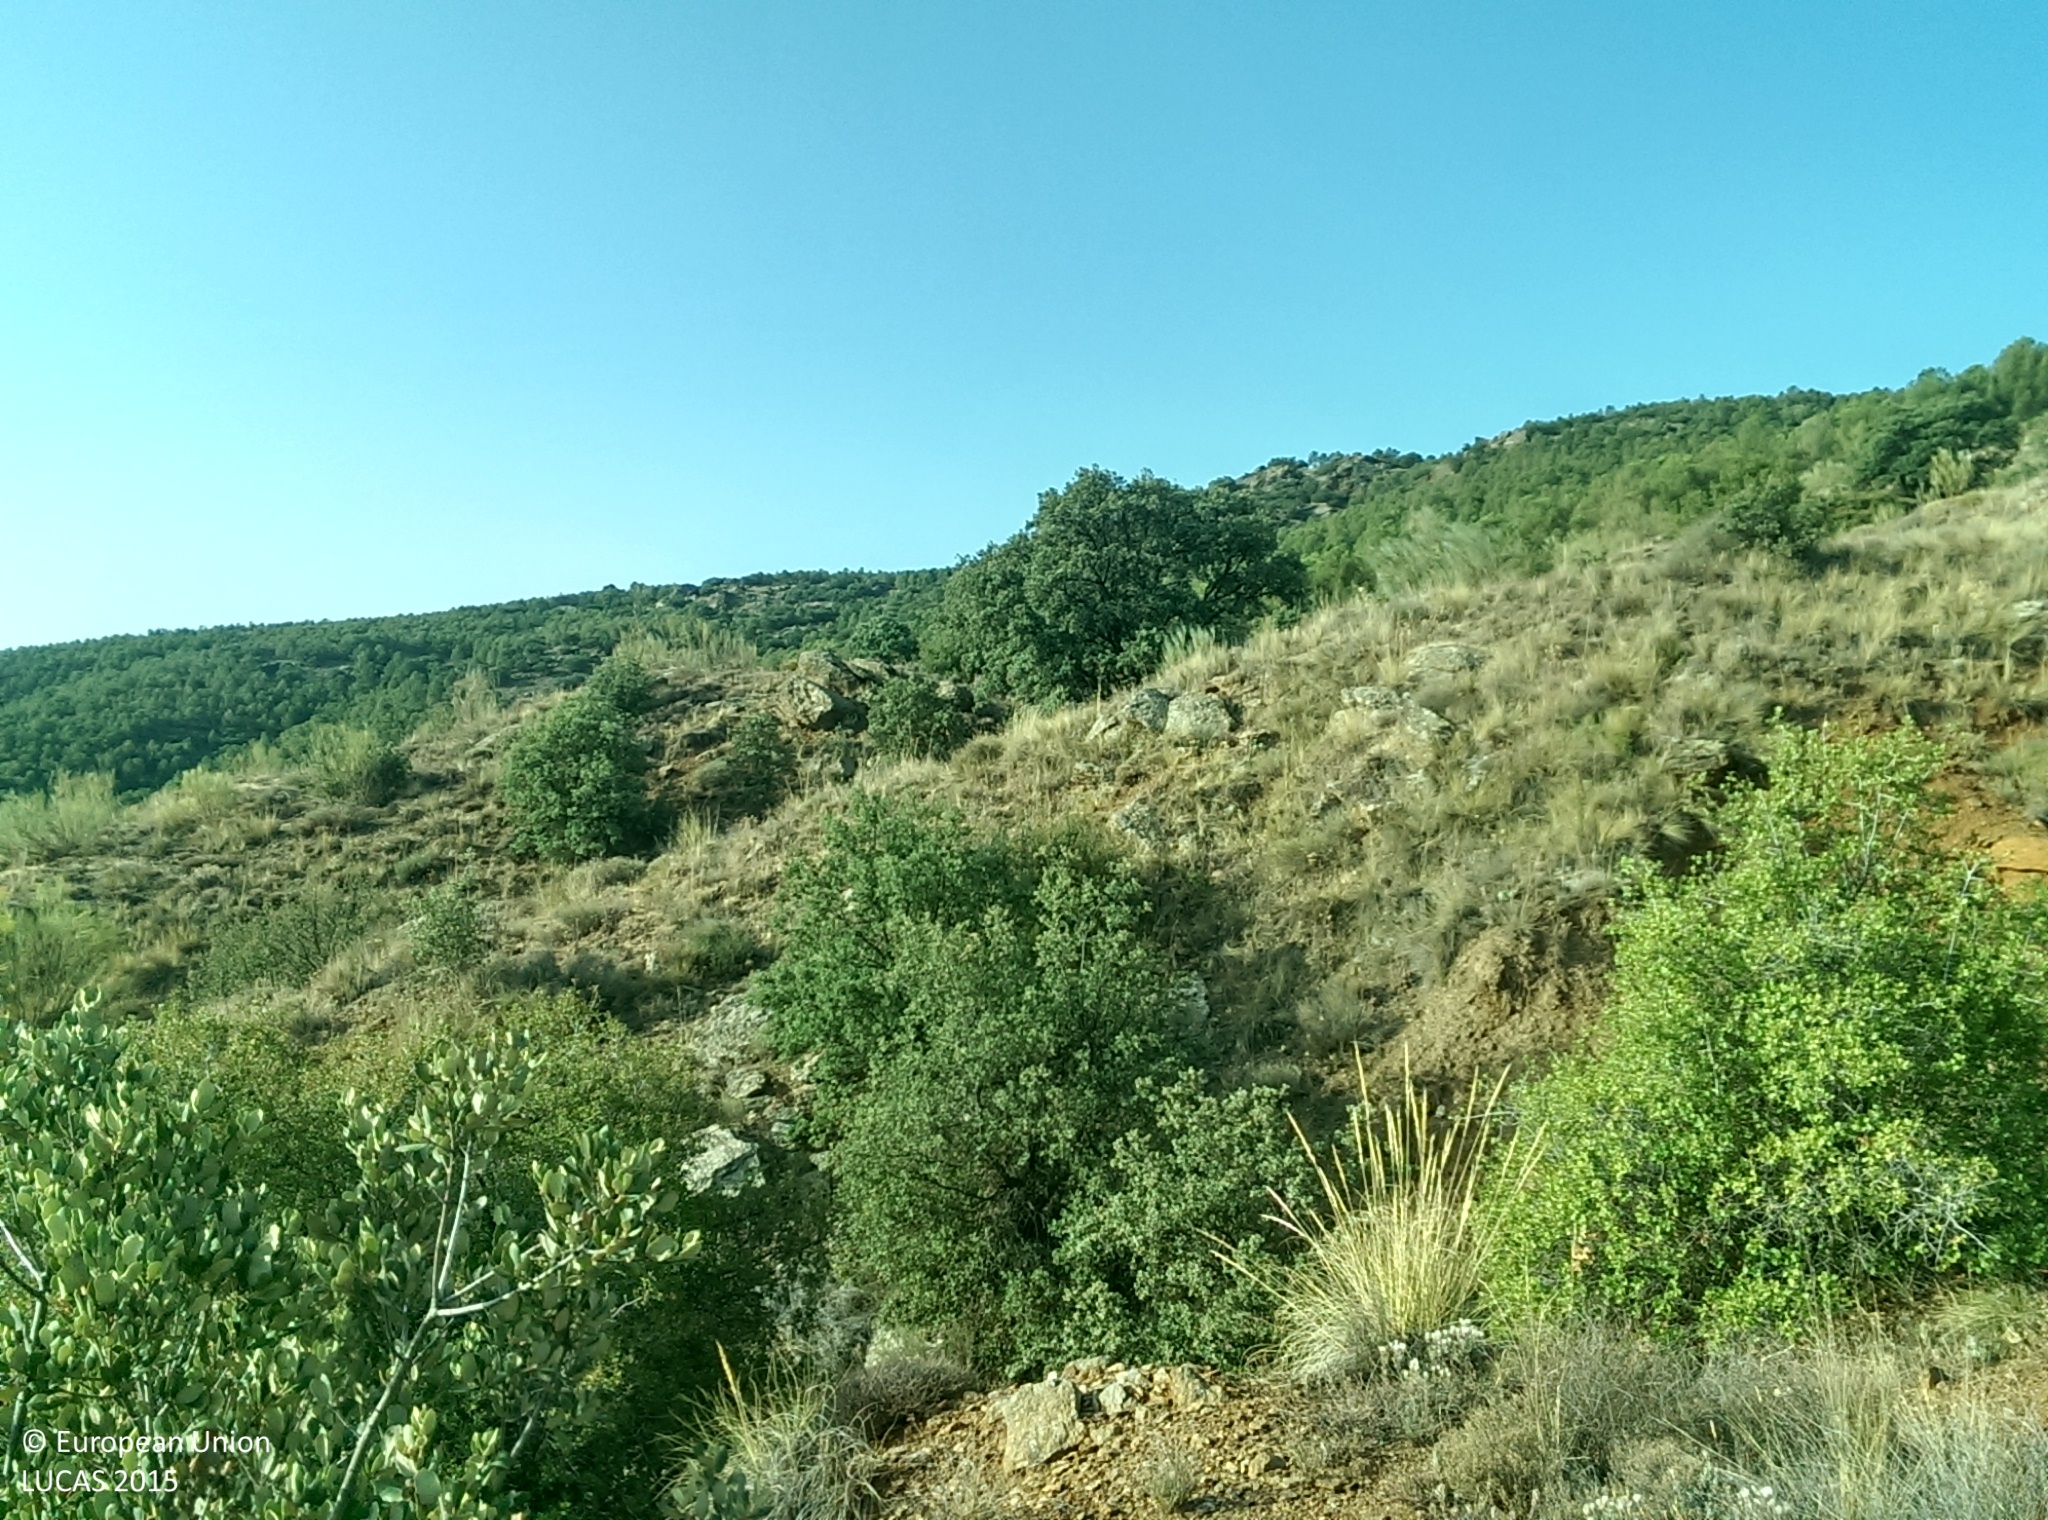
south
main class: Shrubland
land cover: Shrubland without tree cover
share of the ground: 10 - 25 %
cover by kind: herbaceous plants 40 %, unconsolidated bare surface 30 %, shrubs 20 %, consolidated bare surface 10 %
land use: Forestry
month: July
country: ES
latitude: 37.1468
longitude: -2.8511
